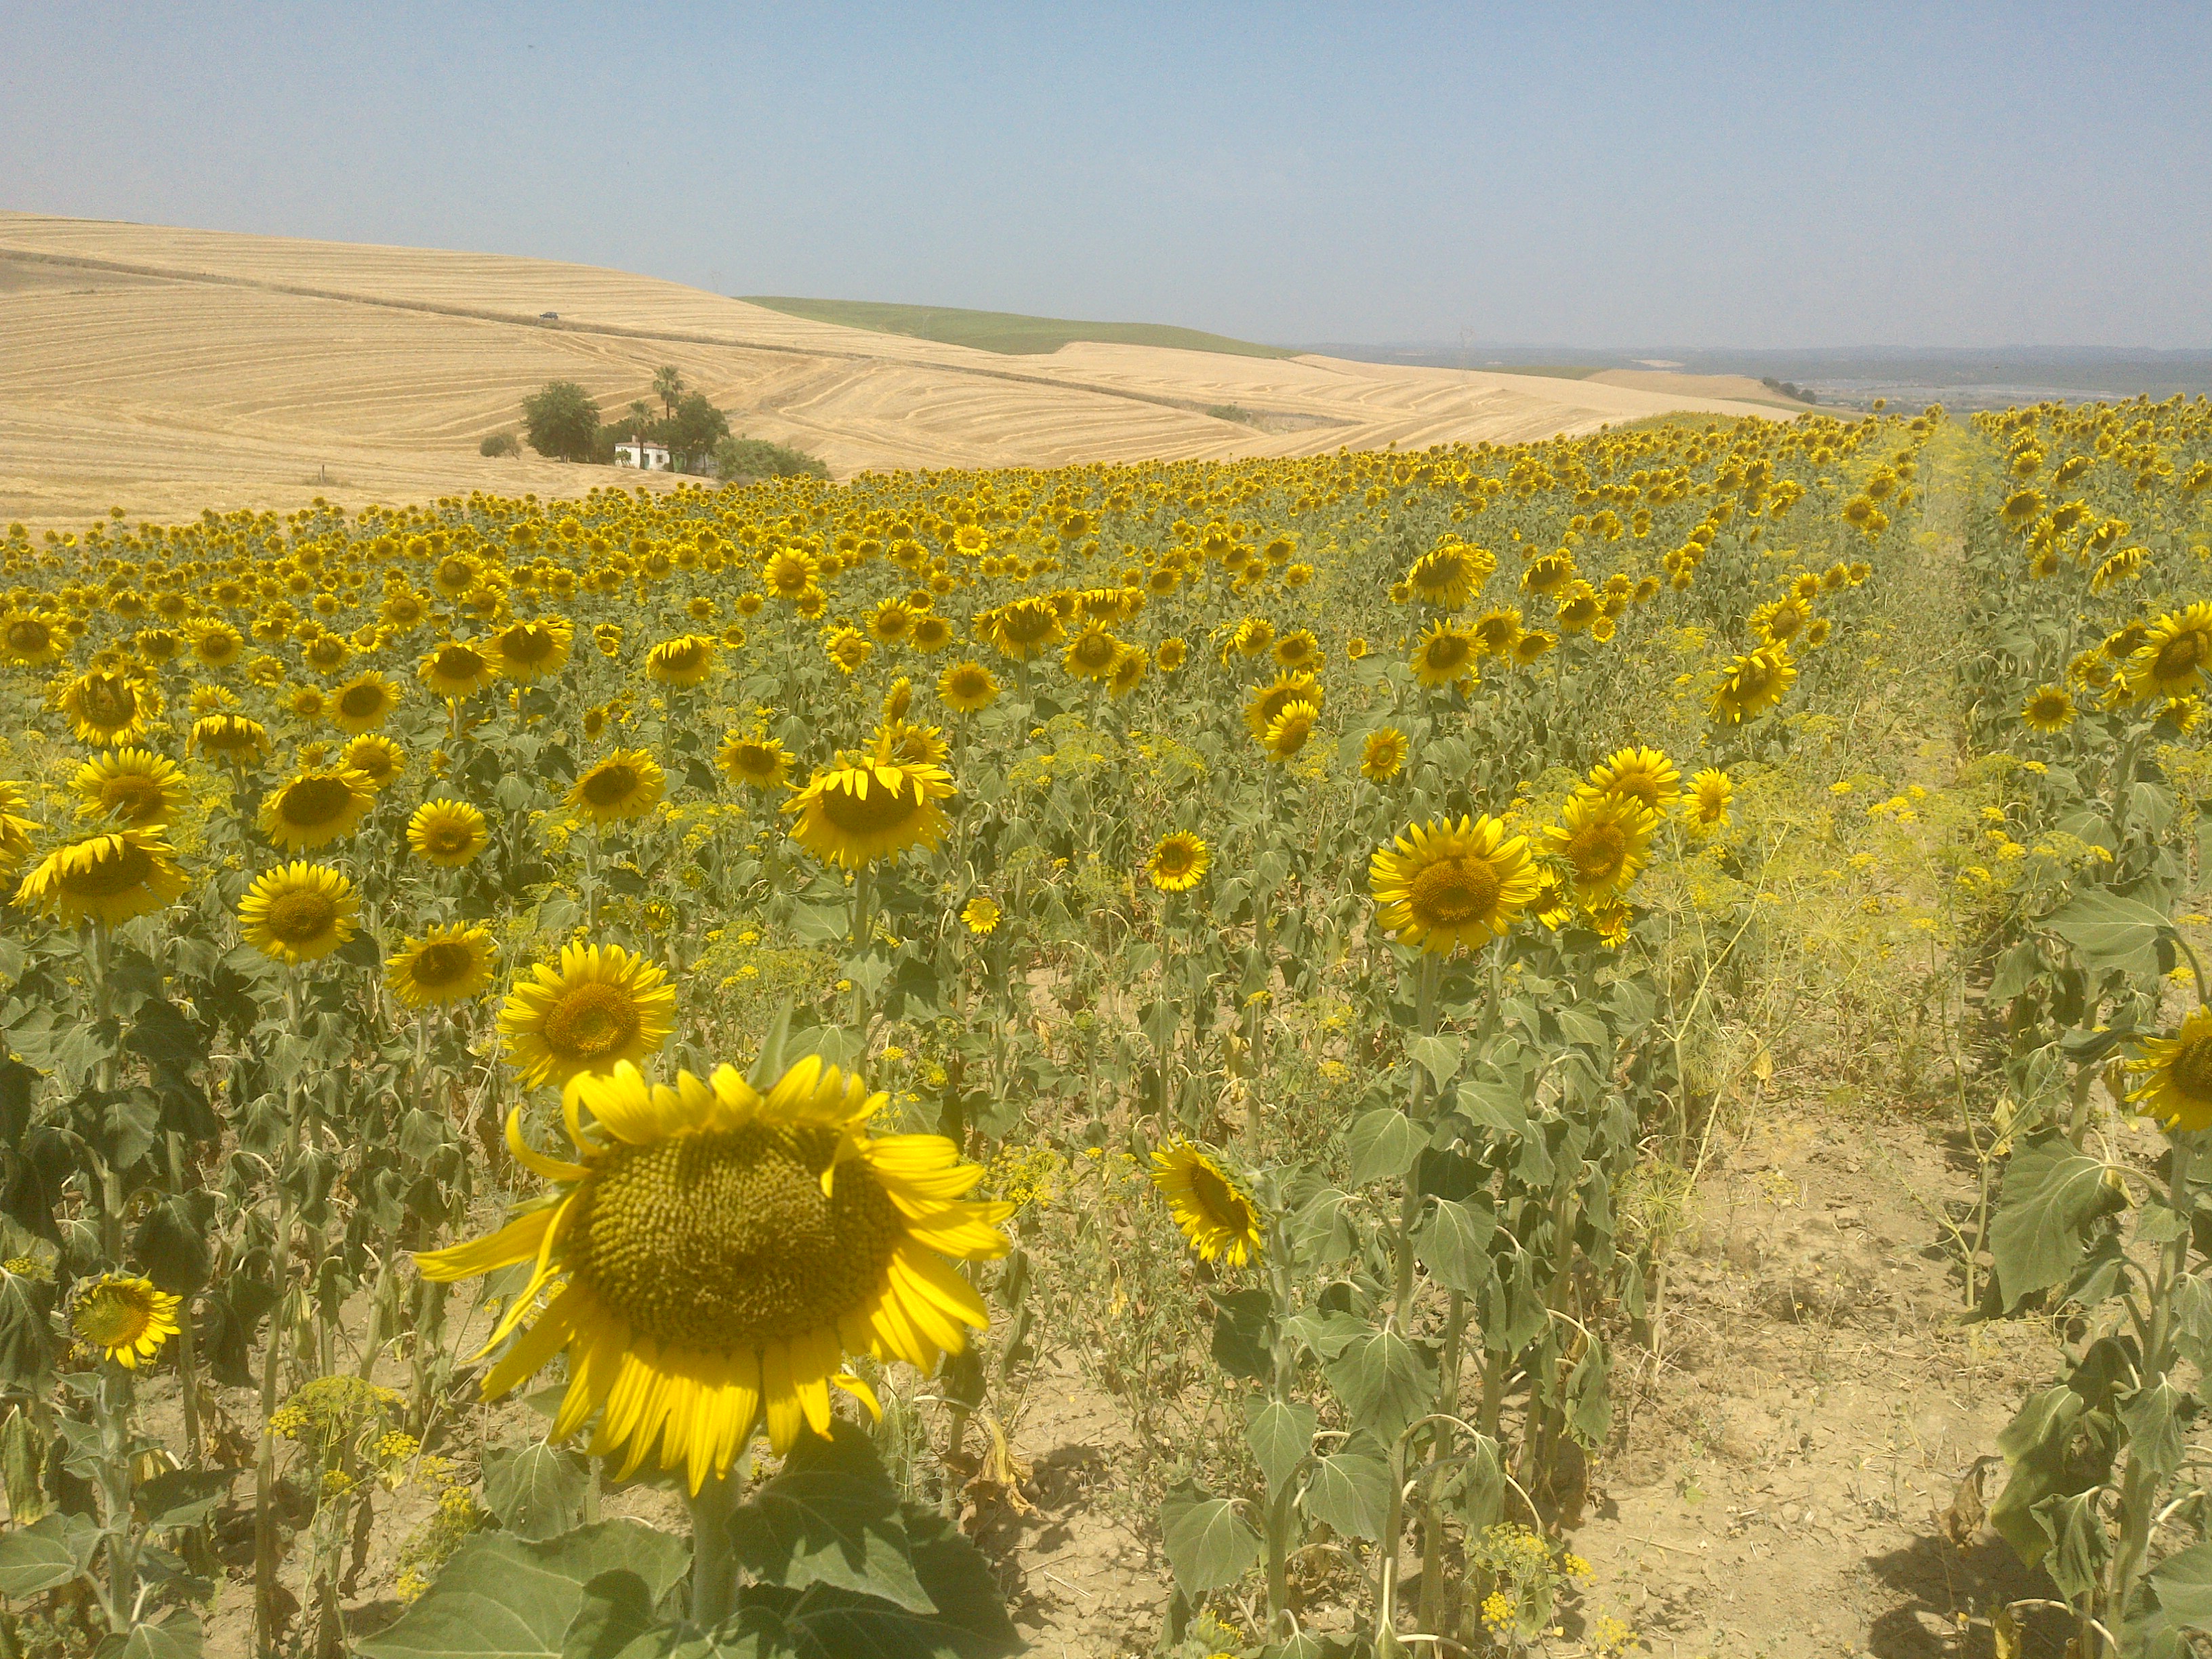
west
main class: Cropland
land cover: Sunflower
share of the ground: > 75 %
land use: Agriculture (excluding fallow land and kitchen gardens)
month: June
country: ES
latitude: 37.7987
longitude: -4.9036
